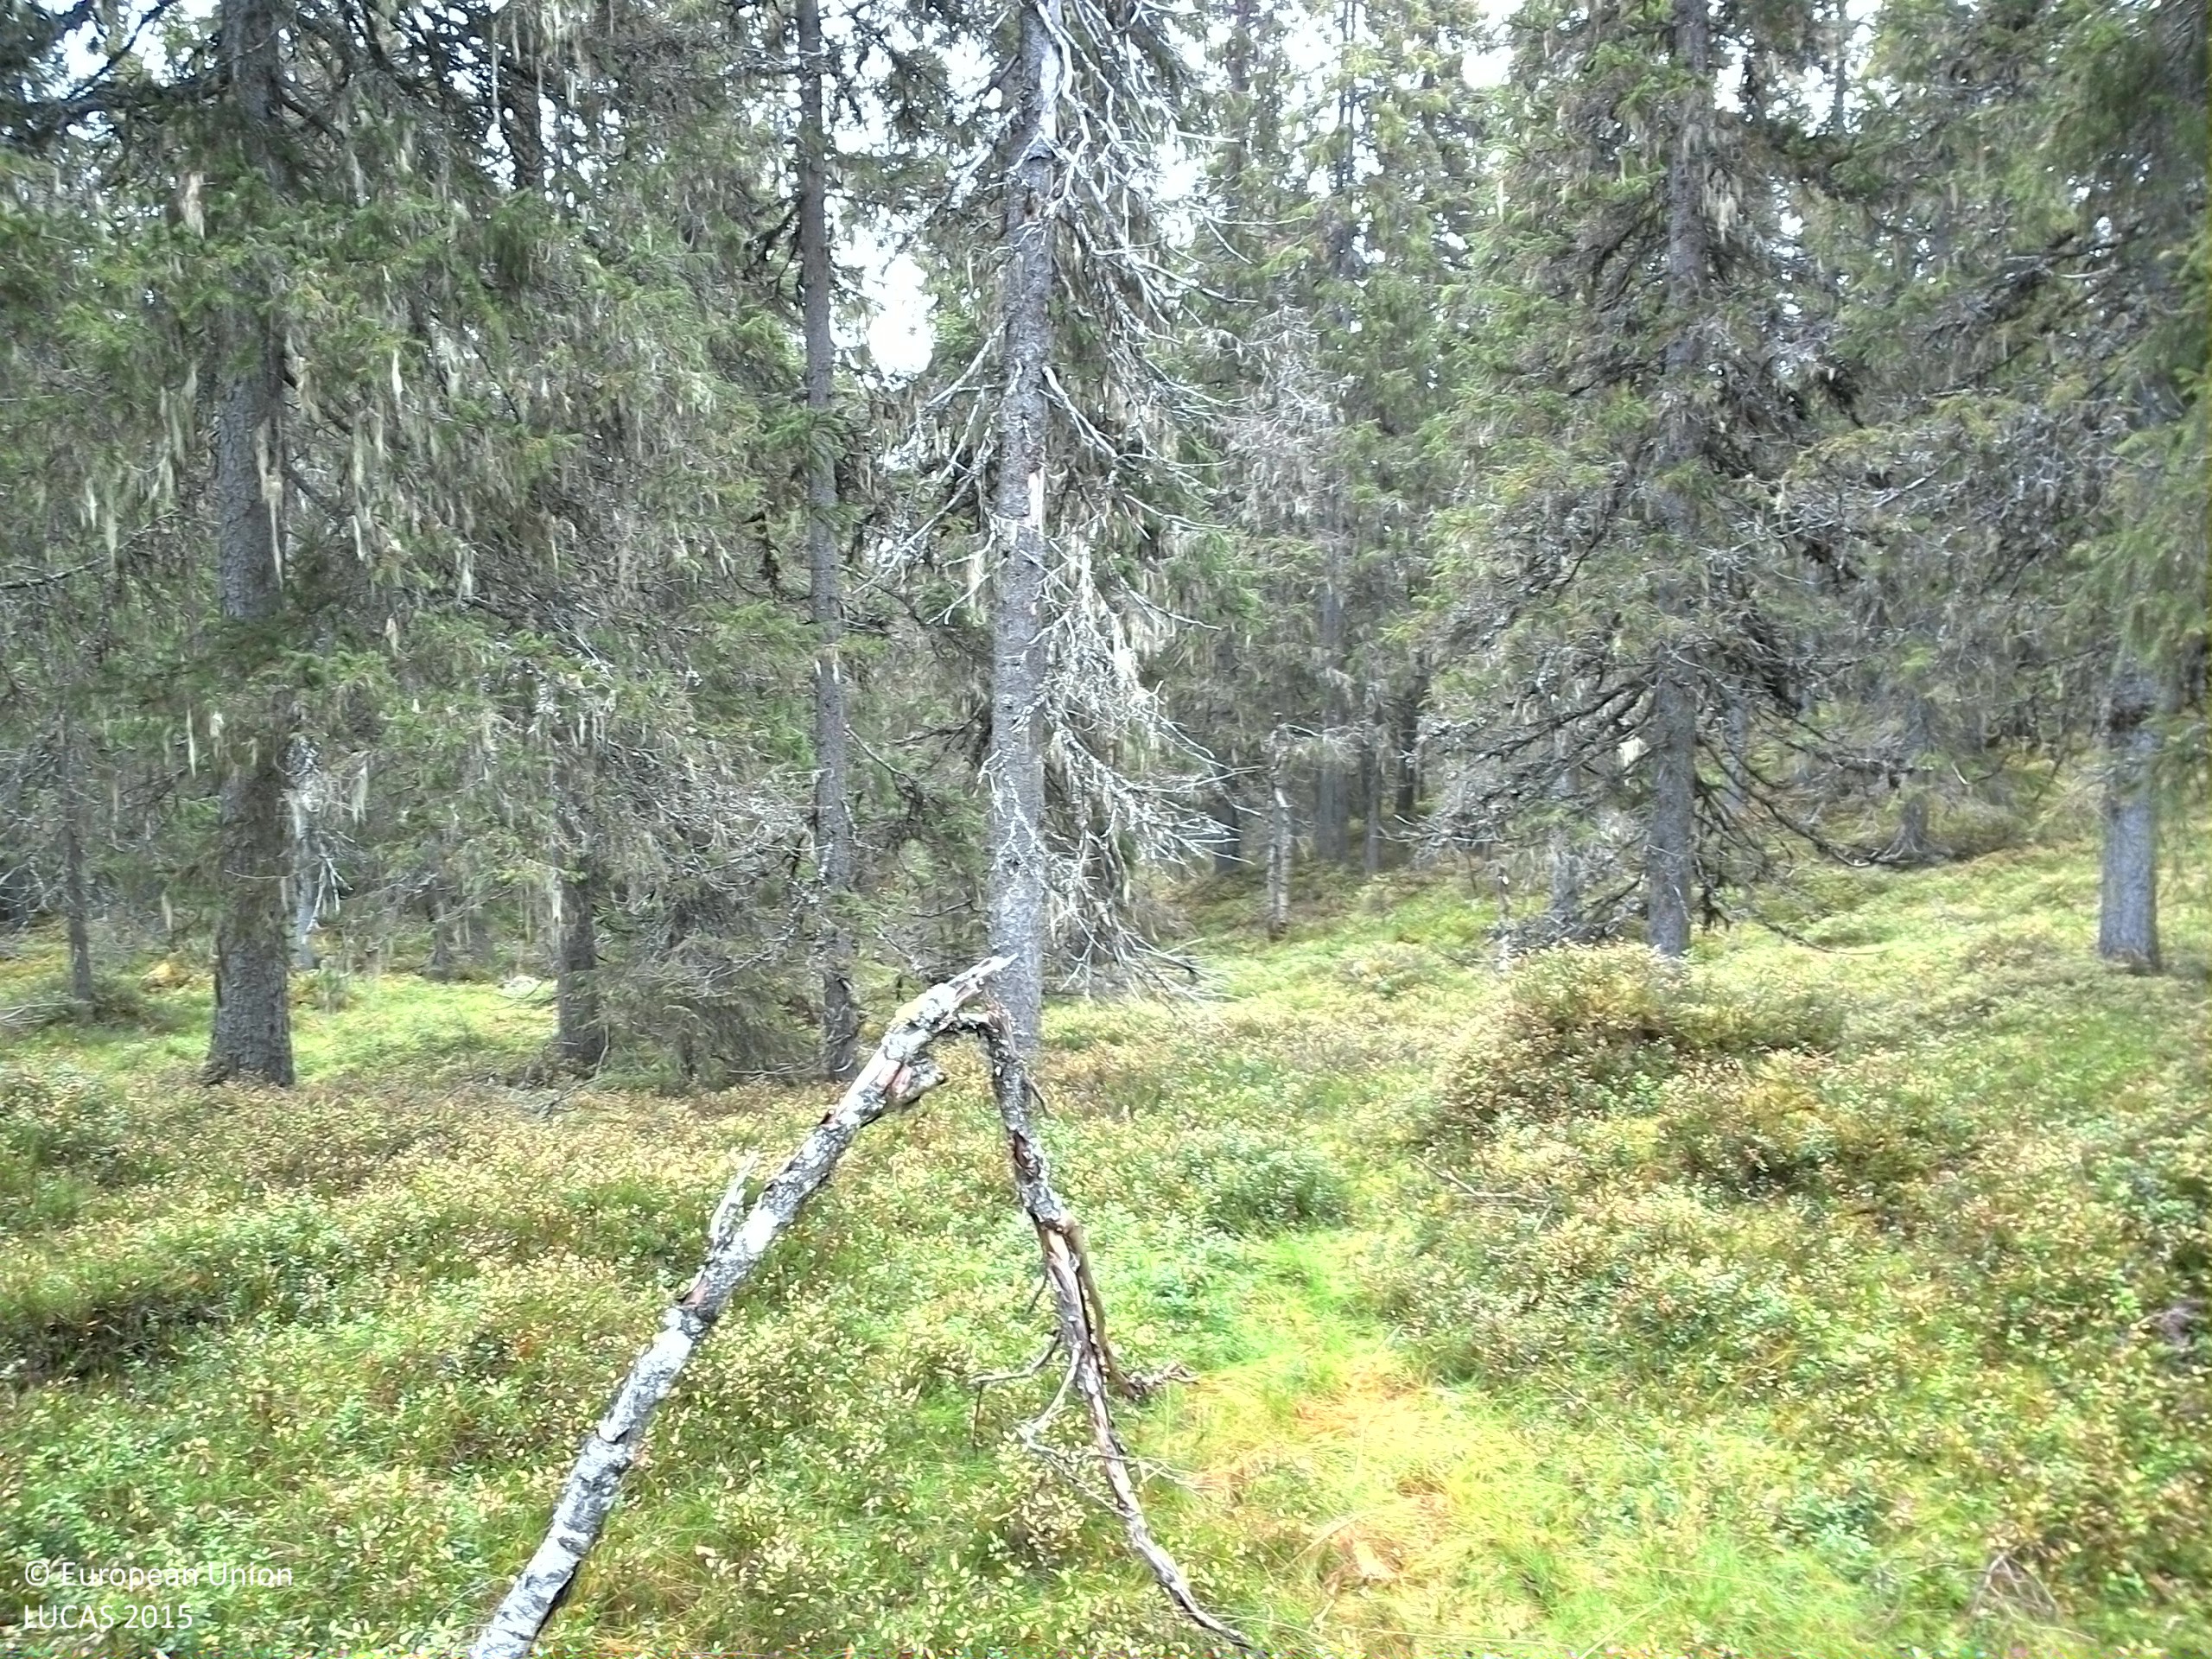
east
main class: Woodland
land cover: Spruce dominated coniferous woodland
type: boreal forest
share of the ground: 25 - 50 %
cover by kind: coniferous forest trees 45 %, shrubs 35 %, lichens and mosses 20 %
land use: Amenities, museums, leisure
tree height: > 5 m
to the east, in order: Spruce dominated coniferous woodland; Paved roads, cycling and walking lanes; Spruce dominated mixed woodland; Spruce dominated coniferous woodland; Peatbogs
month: October
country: SE
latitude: 61.3584
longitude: 14.3433
